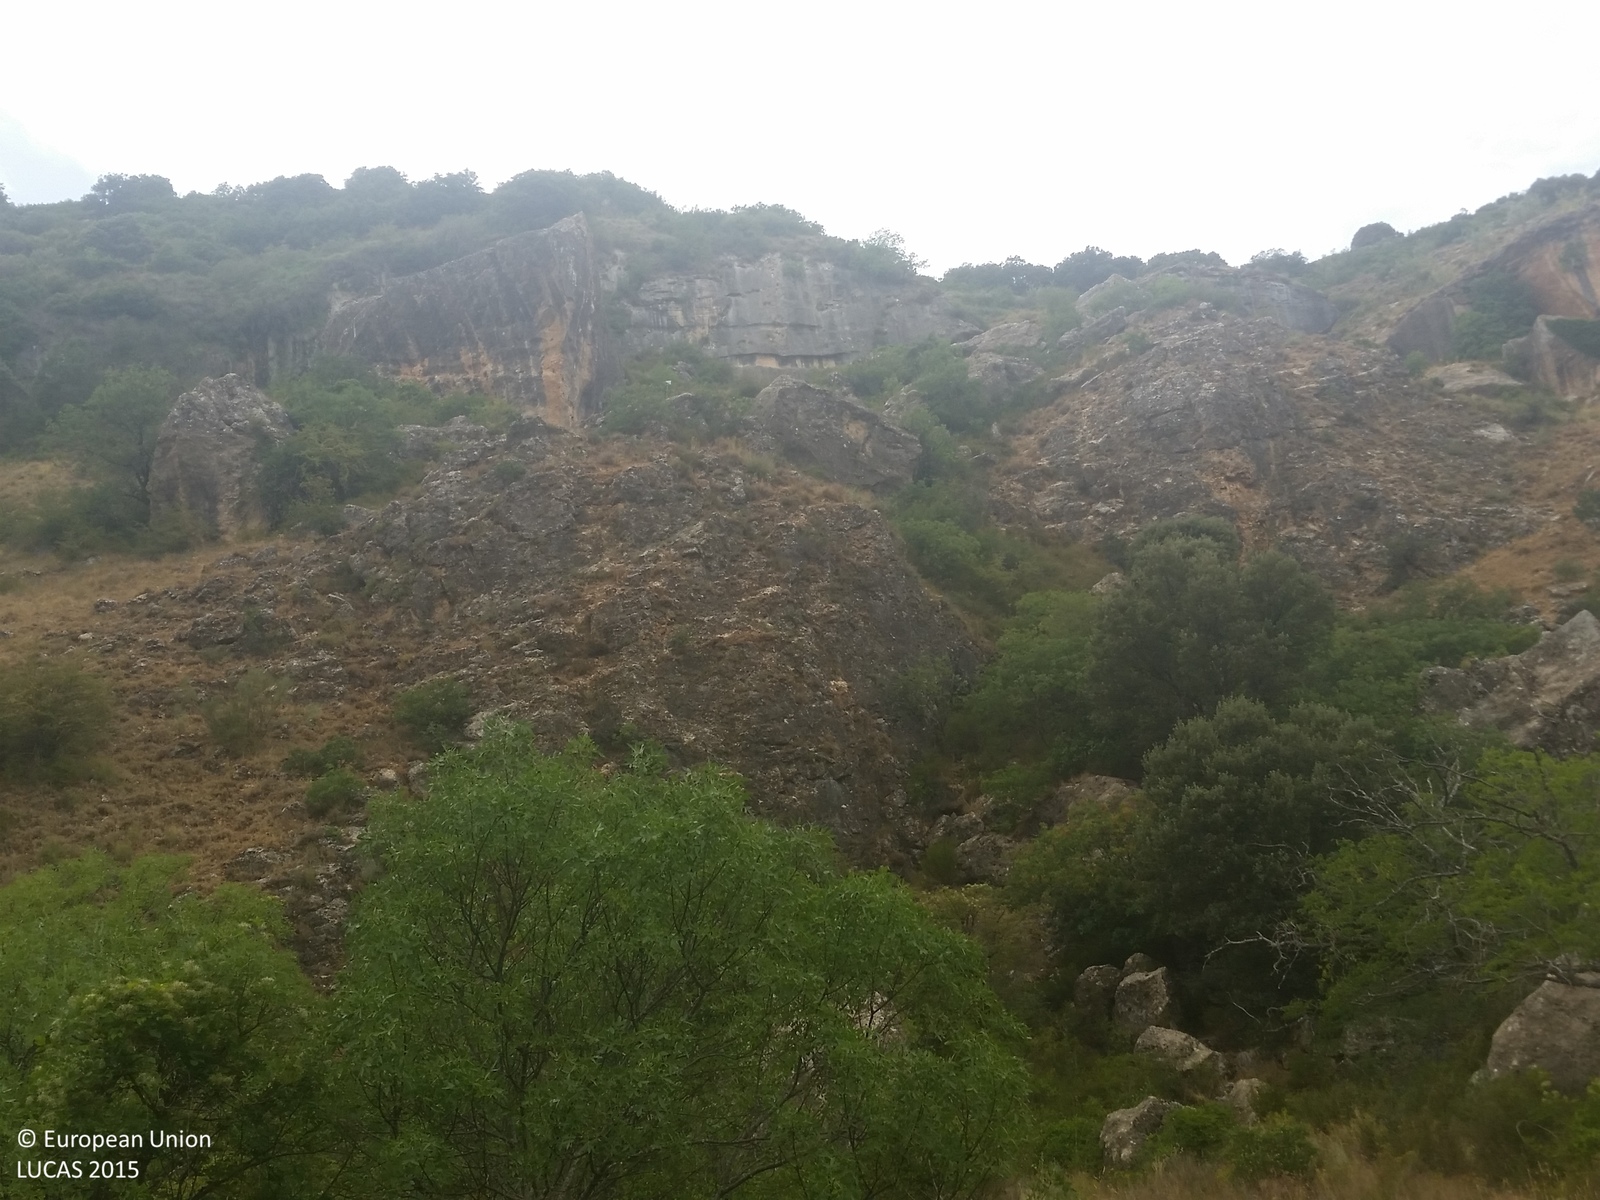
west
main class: Shrubland
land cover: Shrubland without tree cover
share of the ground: > 75 %
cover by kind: shrubs 100 %
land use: Semi-natural and natural areas not in use
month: August
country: ES
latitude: 38.6455
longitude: -2.4669
